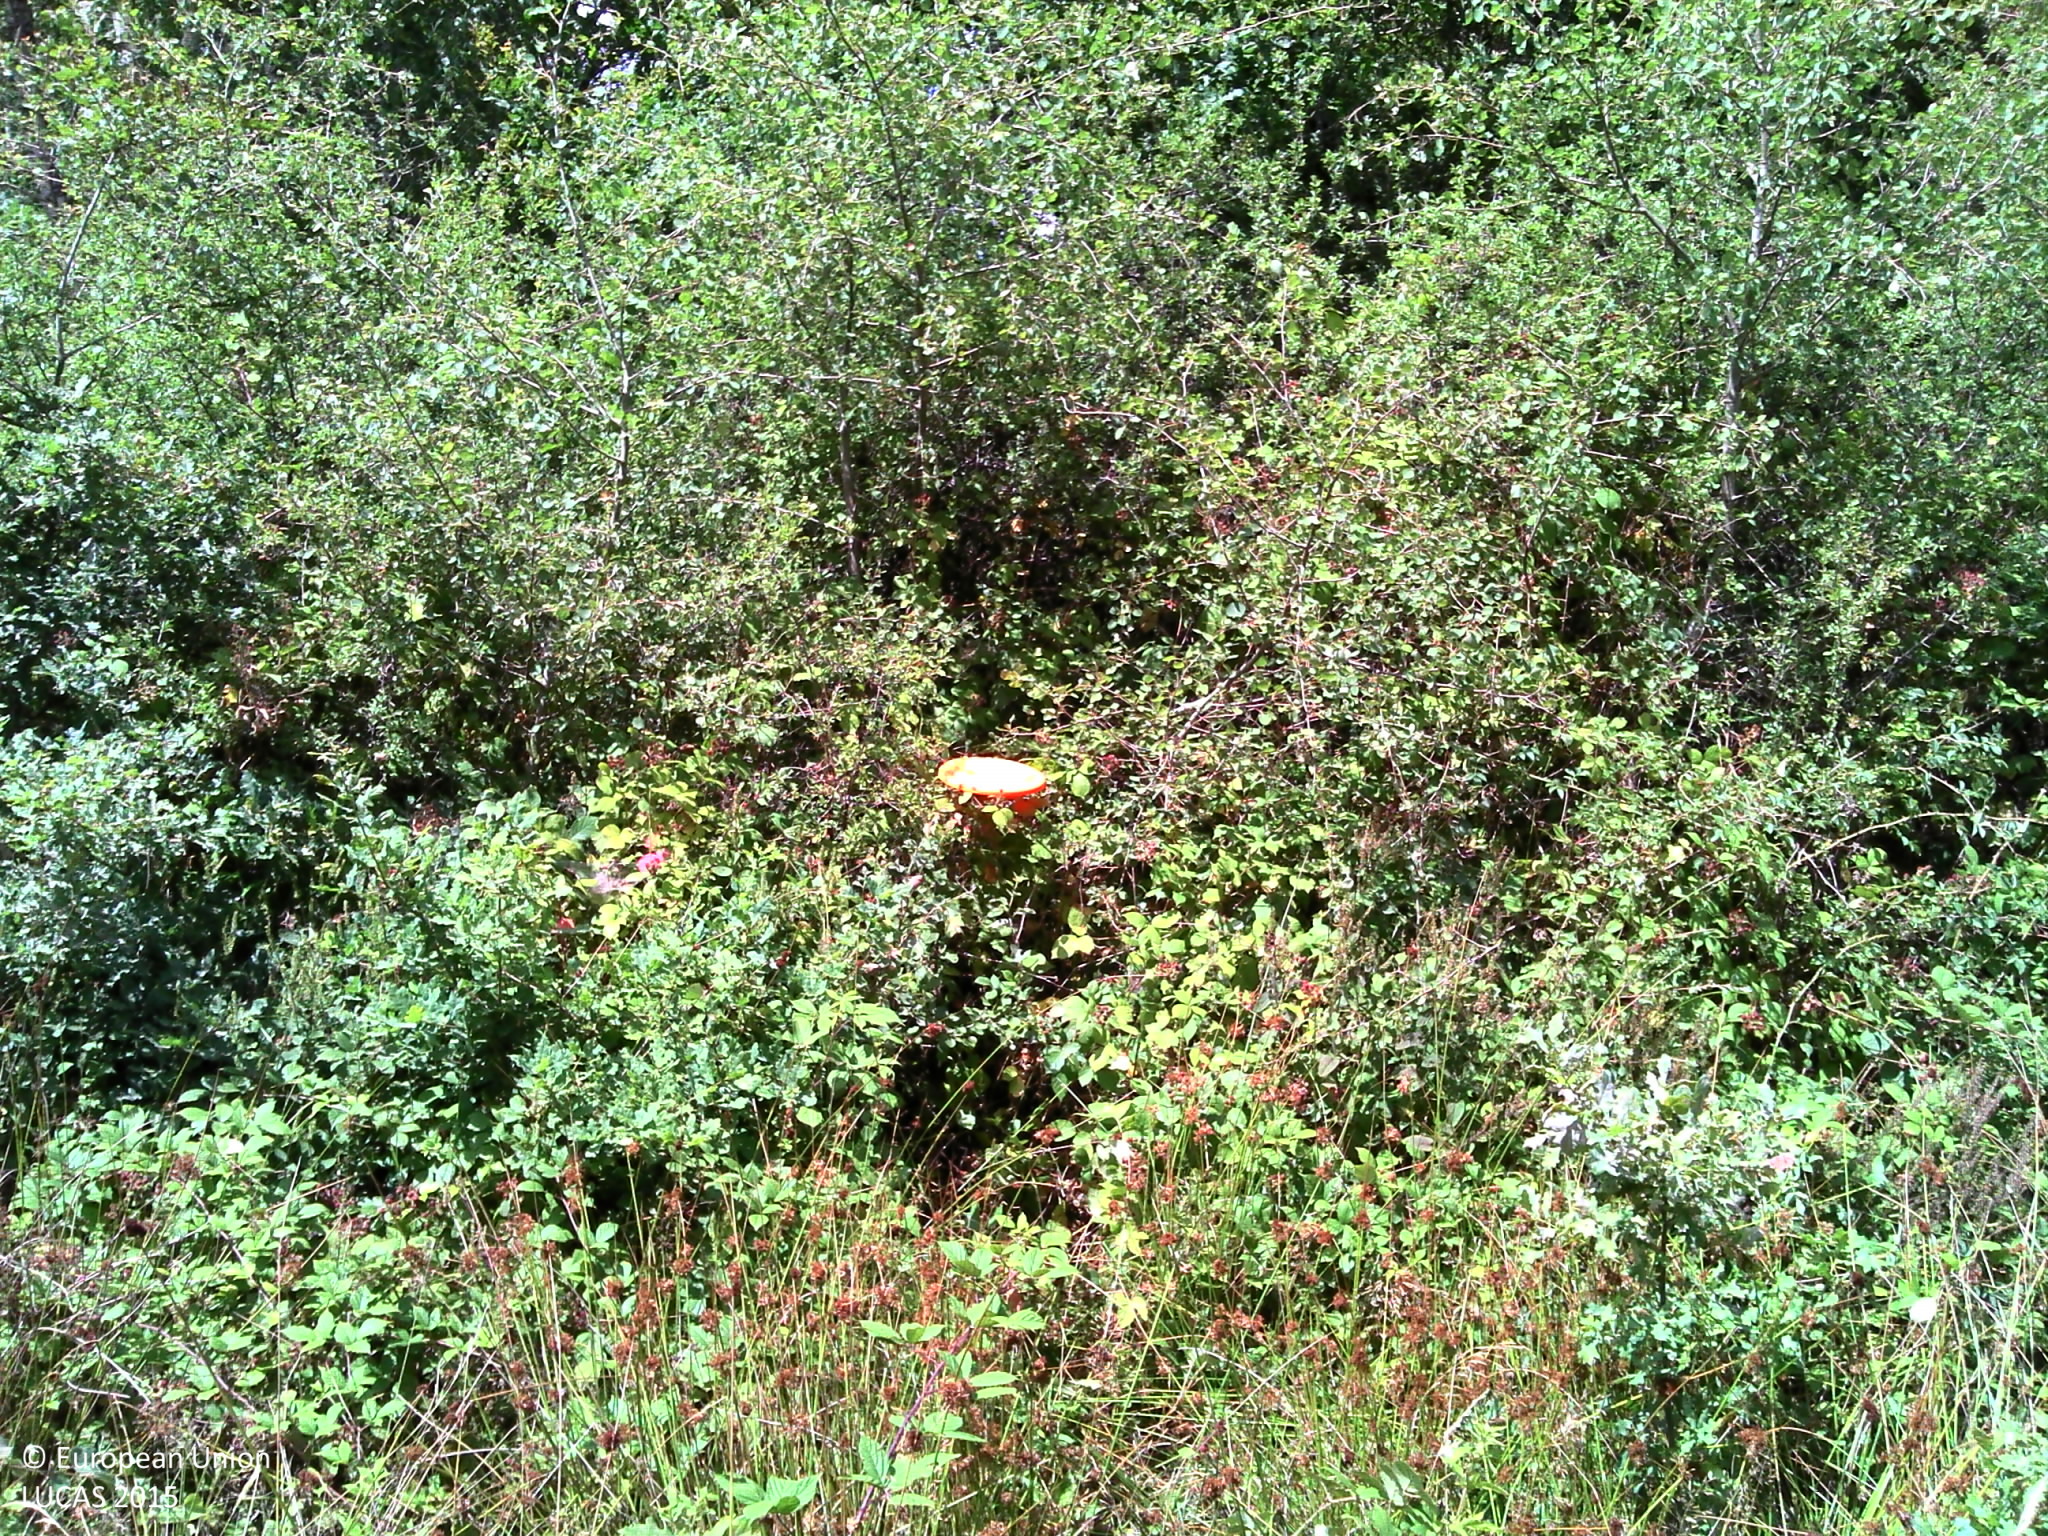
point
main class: Woodland
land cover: Broadleaved woodland
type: mesophytic deciduous forest
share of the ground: > 75 %
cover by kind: broadleaved forest trees 90 %, herbaceous plants 5 %, lichens and mosses 5 %
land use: Semi-natural and natural areas not in use
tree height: > 5 m
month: July
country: FR
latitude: 47.5589
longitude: 3.1503
